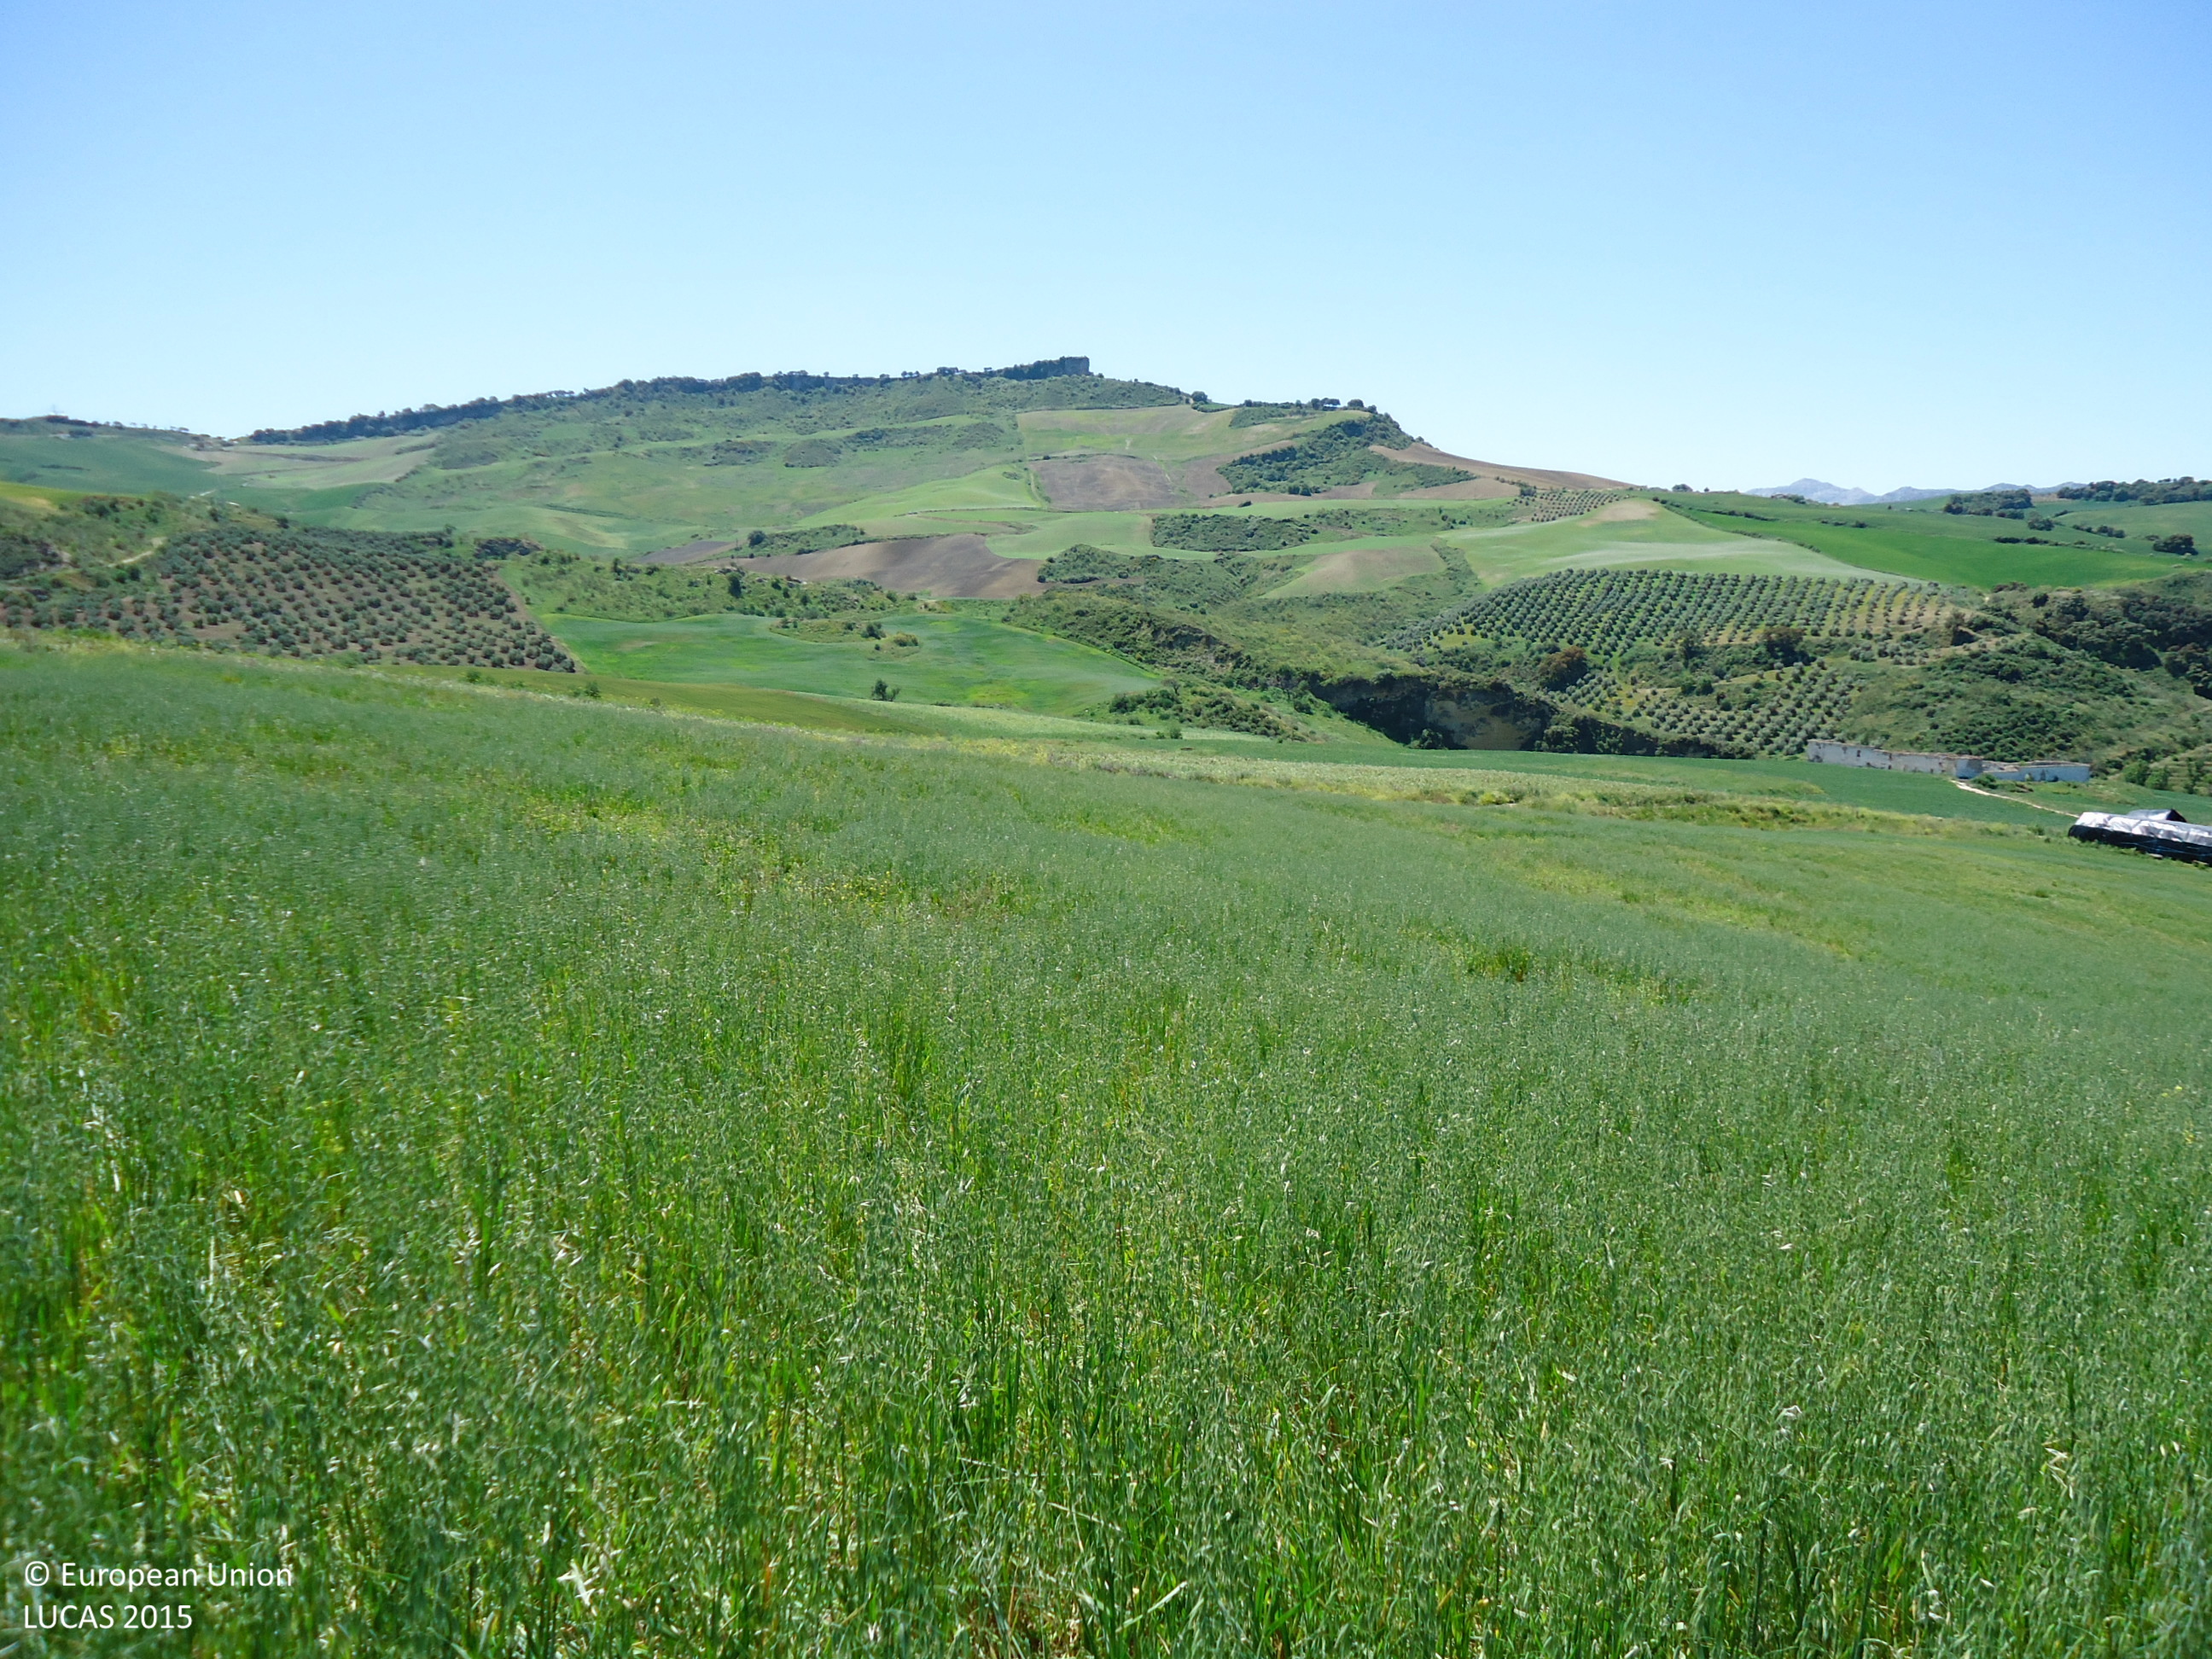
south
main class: Cropland
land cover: Oats
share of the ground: > 75 %
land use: Agriculture (excluding fallow land and kitchen gardens)
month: May
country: ES
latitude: 36.8212
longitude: -5.2599
